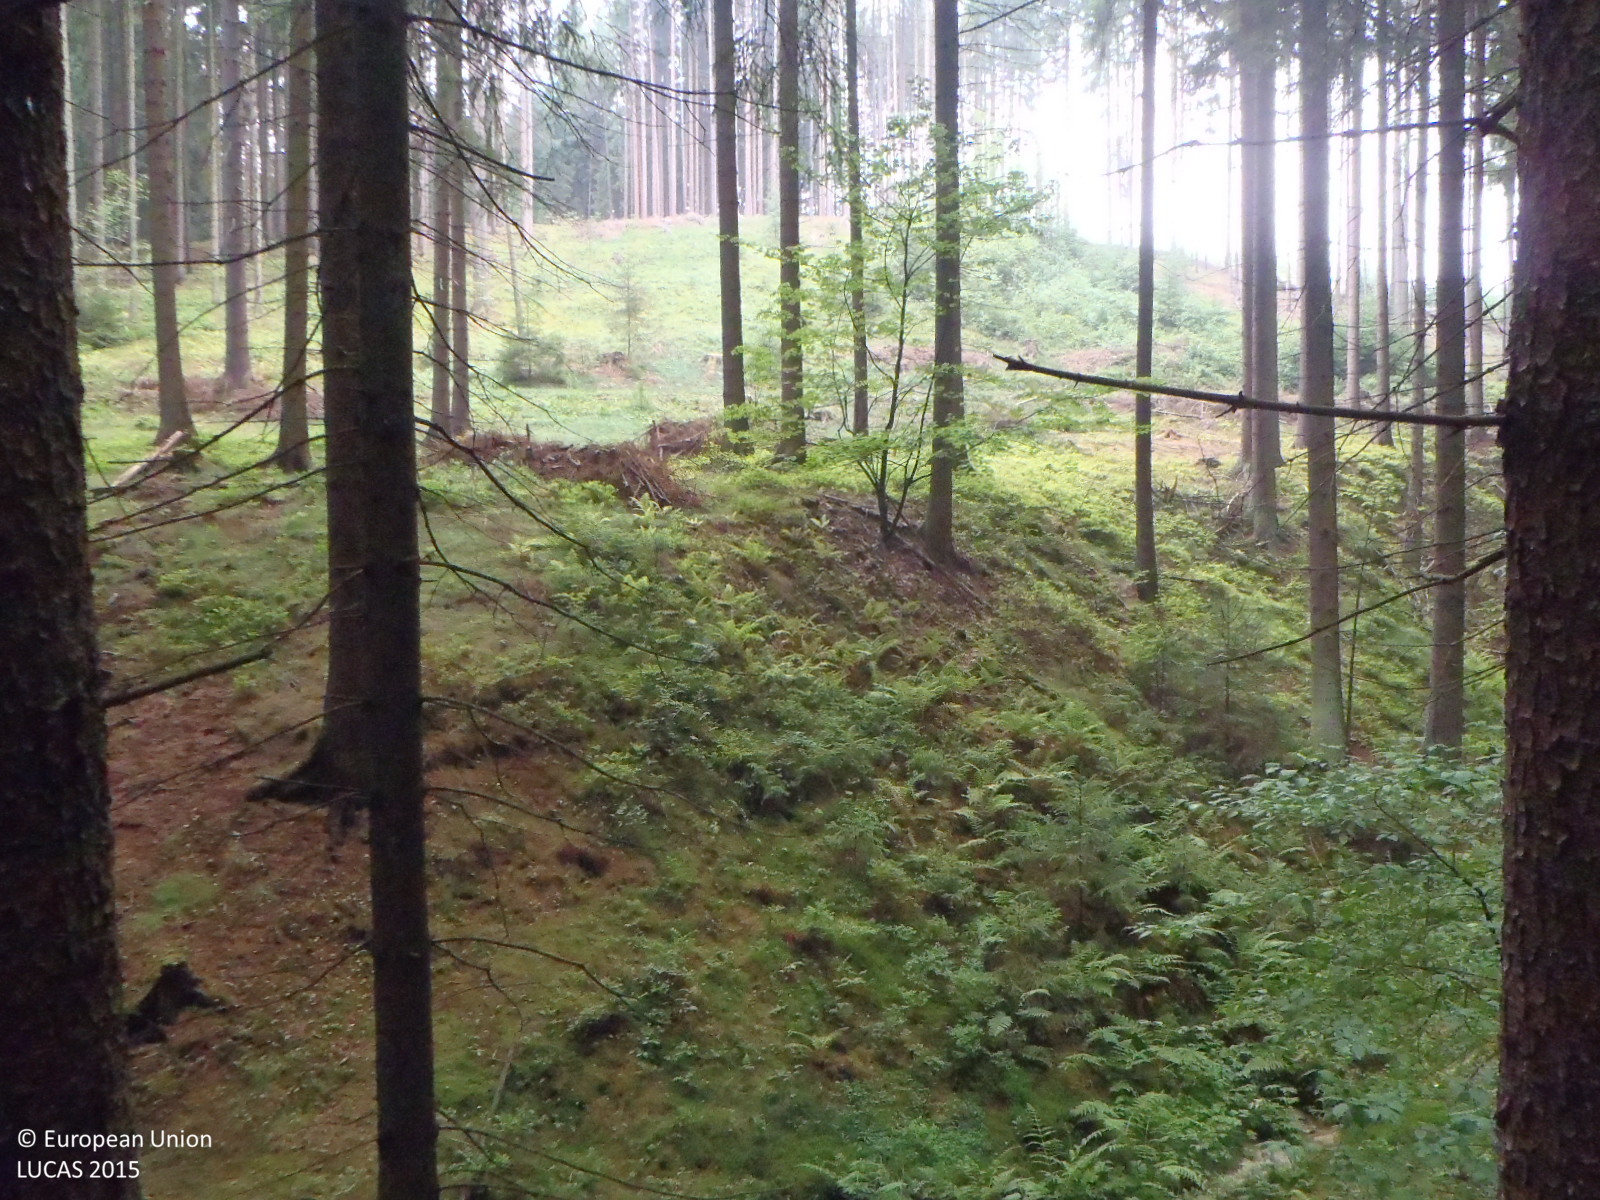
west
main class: Woodland
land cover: Spruce dominated coniferous woodland
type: hemiboreal forest and nemoral coniferous forest and mixed broadleaved-coniferous forest
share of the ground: > 75 %
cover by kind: coniferous forest trees 100 %
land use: Forestry
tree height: > 5 m
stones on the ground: < 10 %
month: August
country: CZ
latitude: 50.6705
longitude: 14.9693
